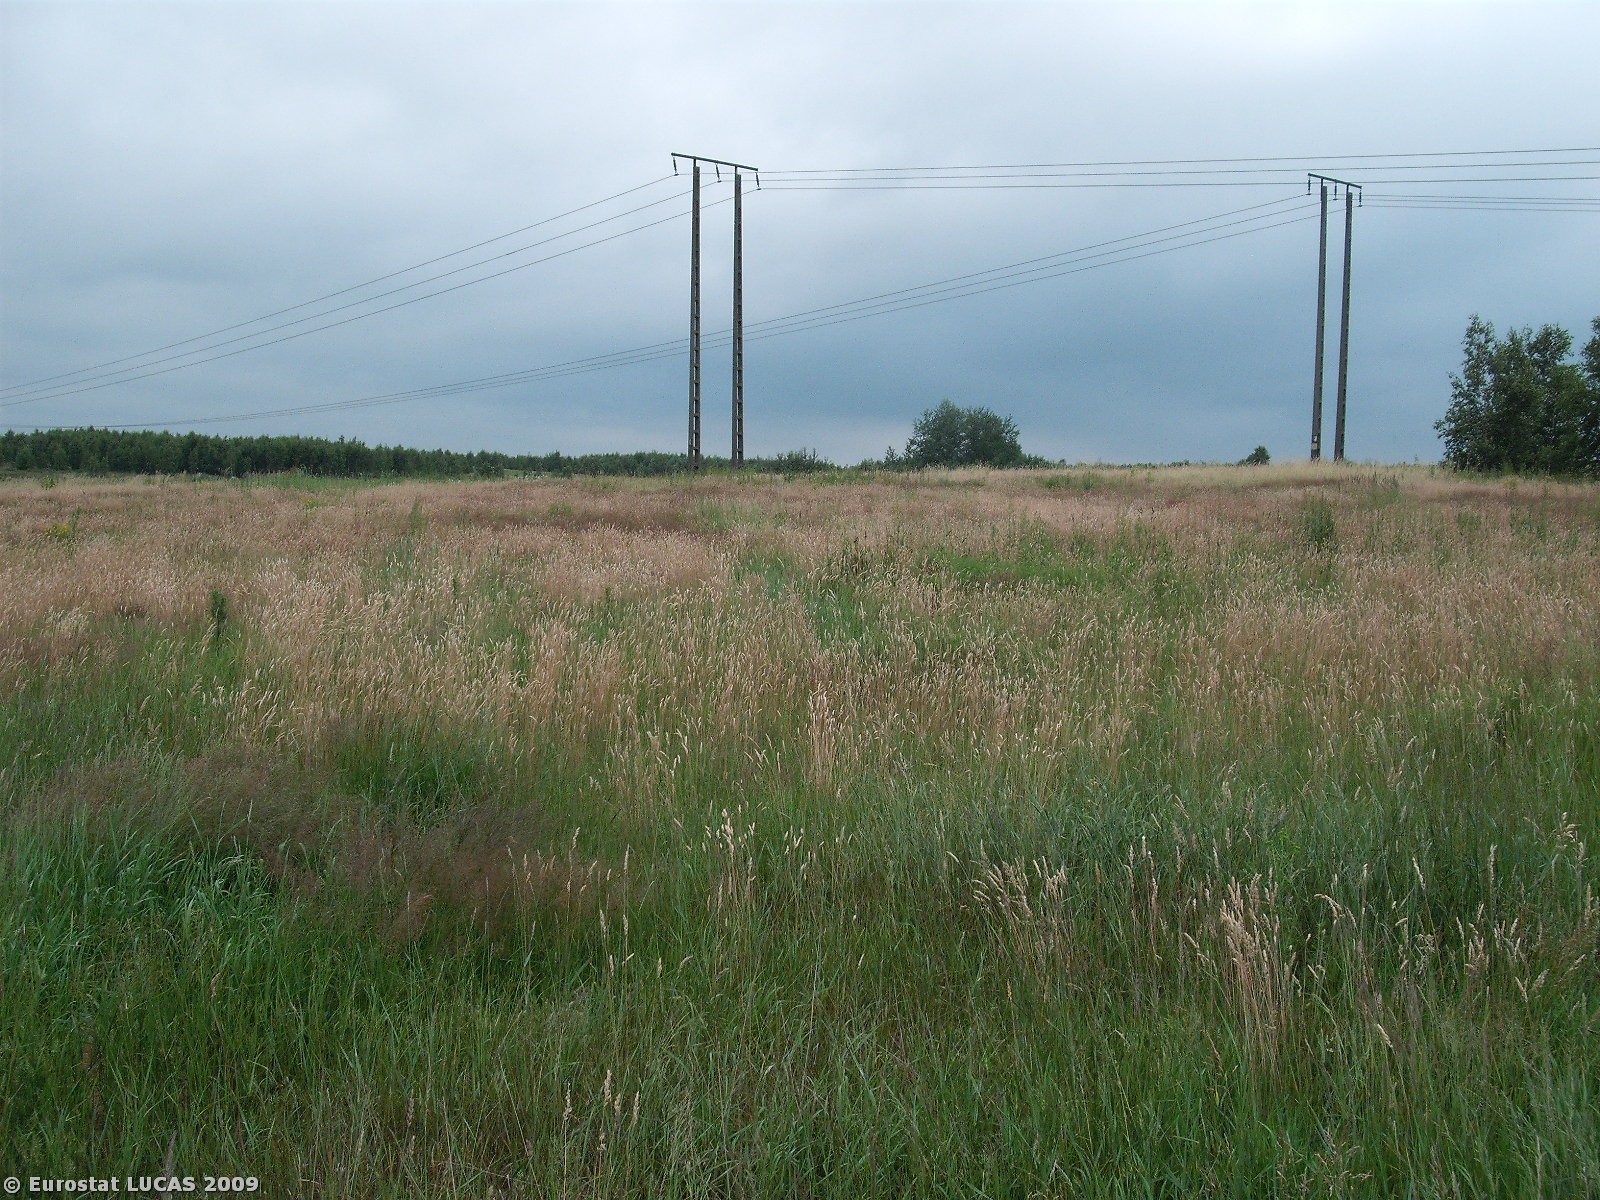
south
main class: Grassland
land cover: Grassland without tree/shrub cover
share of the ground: > 75 %
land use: Fallow land
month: June
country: PL
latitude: 51.3907
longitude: 20.6314
